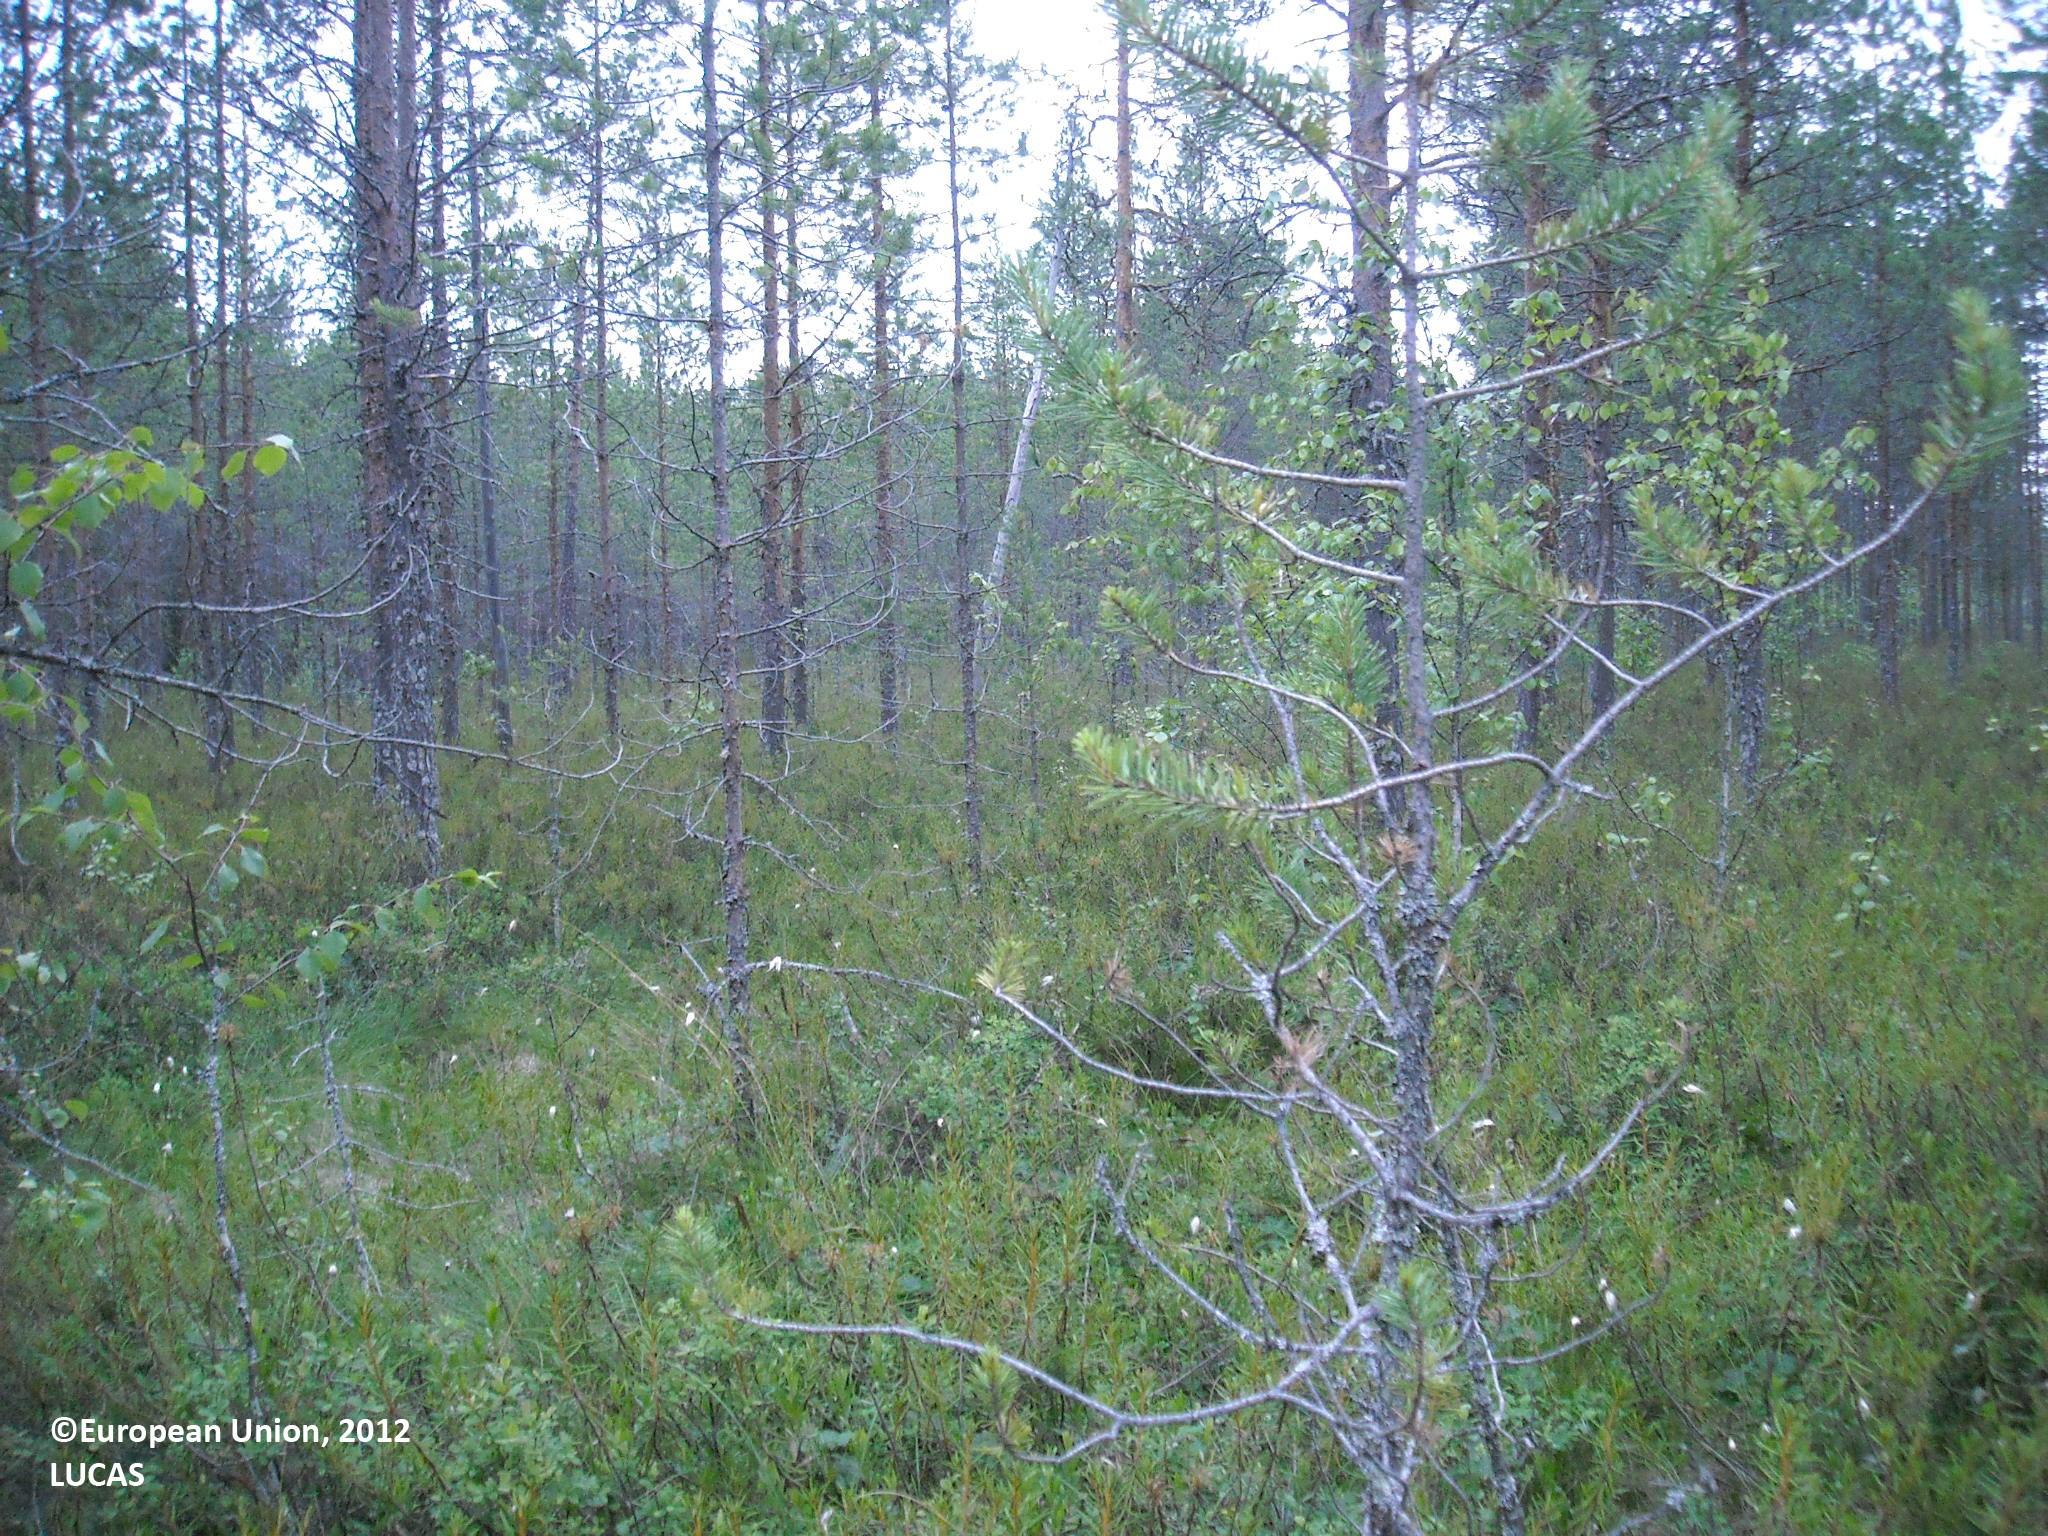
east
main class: Woodland
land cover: Pine dominated coniferous woodland
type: mire and swamp forests
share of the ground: 50 - 75 %
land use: Forestry
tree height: > 5 m
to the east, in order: Pine dominated coniferous woodland; Ditches and canals; Pine dominated coniferous woodland; Ditches and canals; Pine dominated coniferous woodland
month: July
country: FI
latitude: 65.0354
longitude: 26.7845
